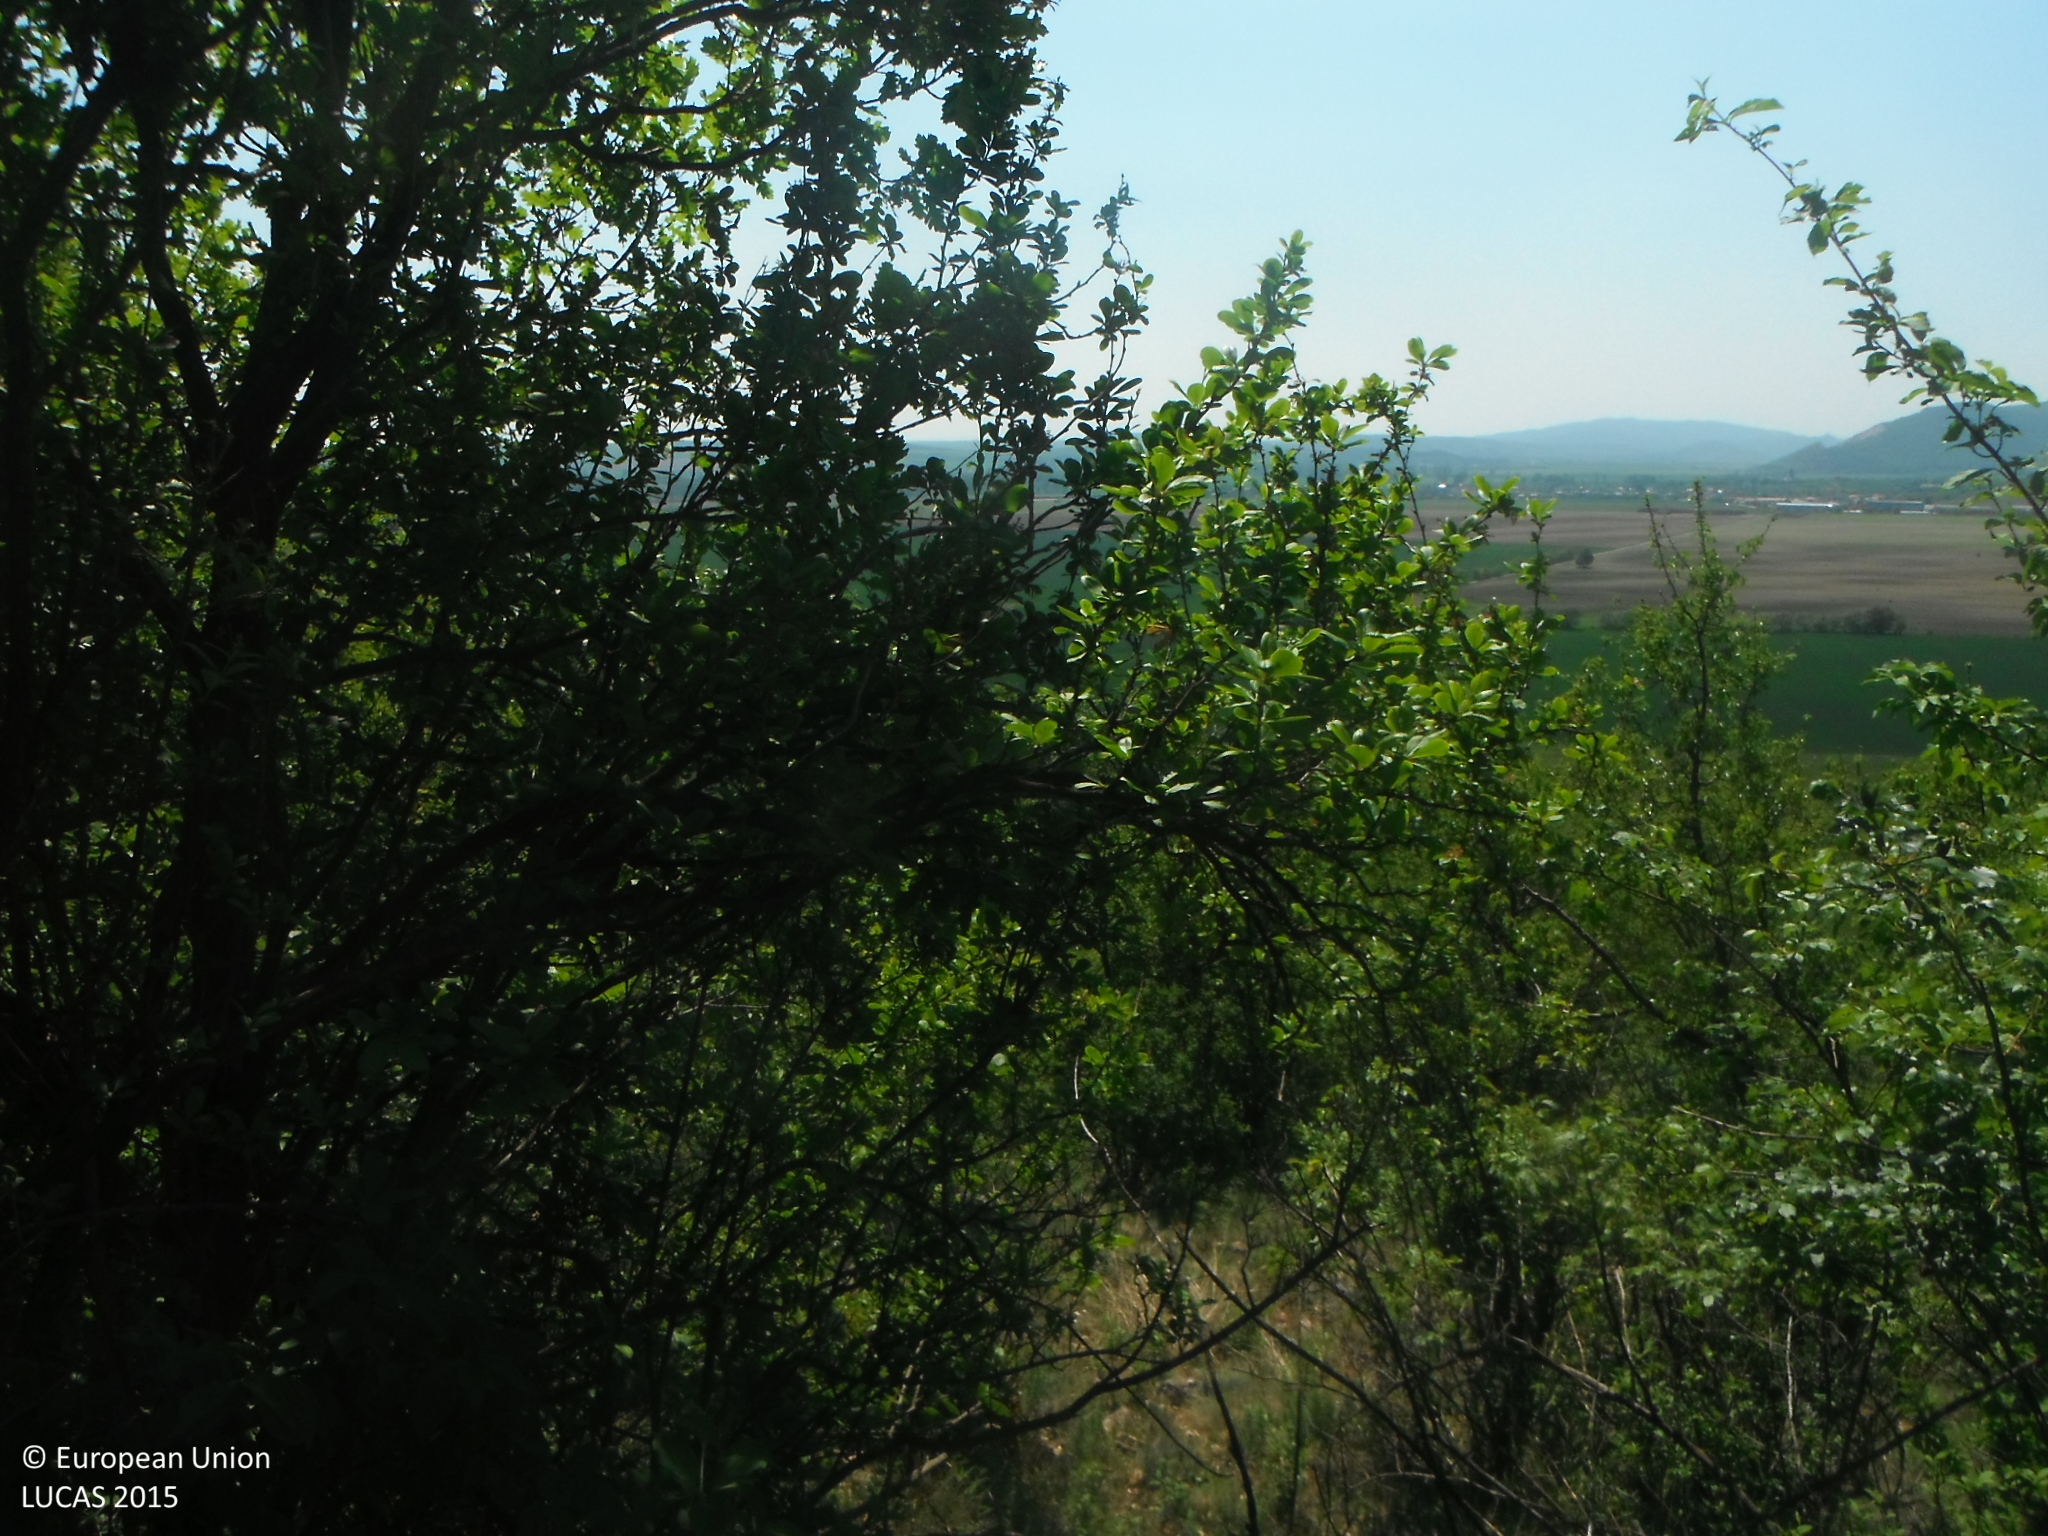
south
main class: Woodland
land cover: Broadleaved woodland
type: mesophytic deciduous forest
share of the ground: 10 - 25 %
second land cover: Shrubland without tree cover
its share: 50 - 75 %
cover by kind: shrubs 60 %, broadleaved forest trees 25 %, herbaceous plants 15 %
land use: Semi-natural and natural areas not in use
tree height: > 5 m
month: May
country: SK
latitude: 48.6247
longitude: 20.9071
